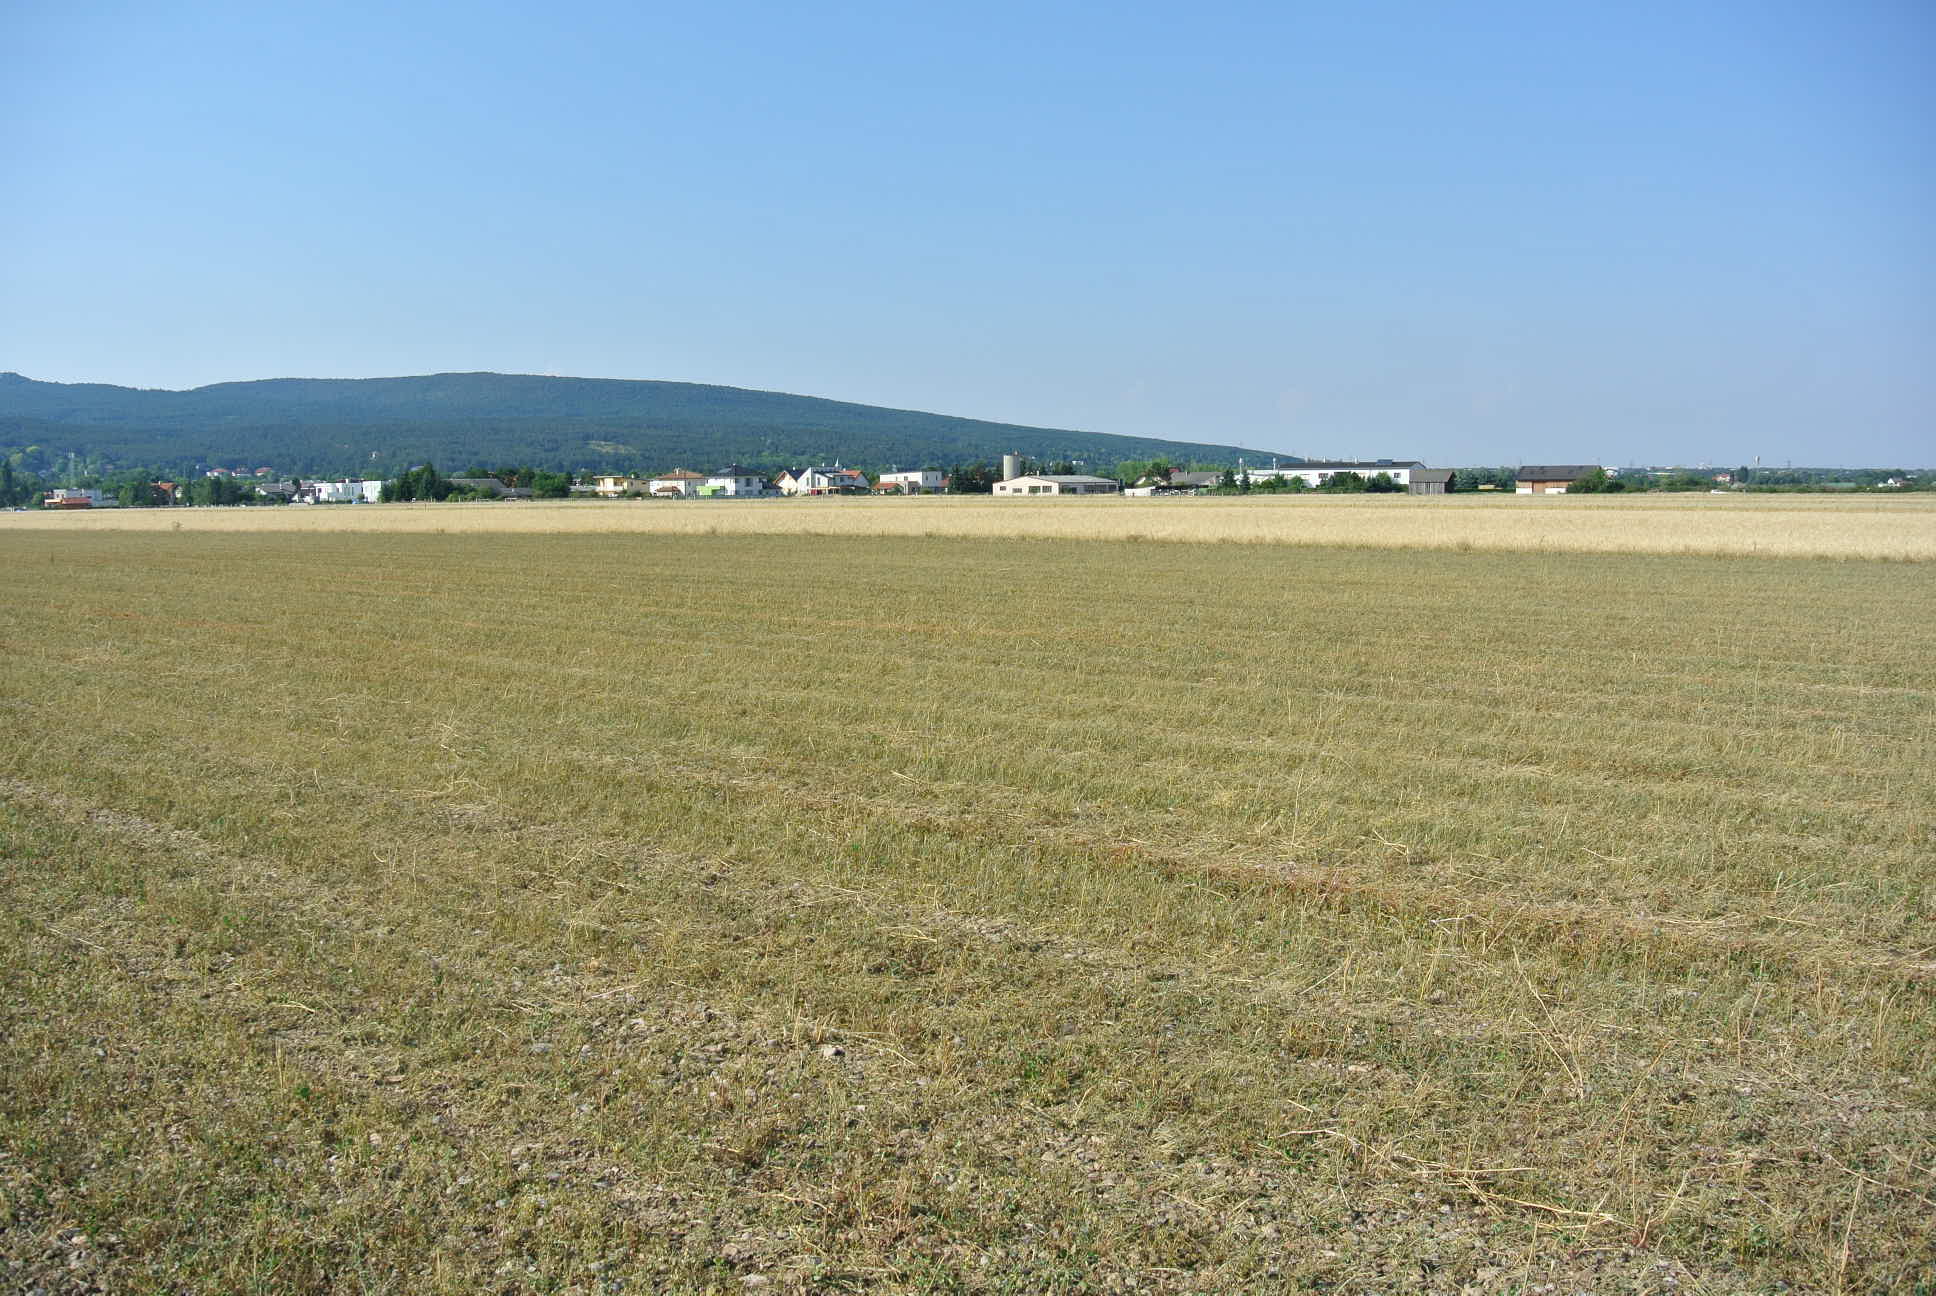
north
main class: Grassland
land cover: Grassland without tree/shrub cover
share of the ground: > 75 %
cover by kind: herbaceous plants 80 %, unconsolidated bare surface 20 %
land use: Agriculture (excluding fallow land and kitchen gardens)
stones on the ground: > 50 %
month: July
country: AT
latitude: 47.8166
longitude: 16.1603
